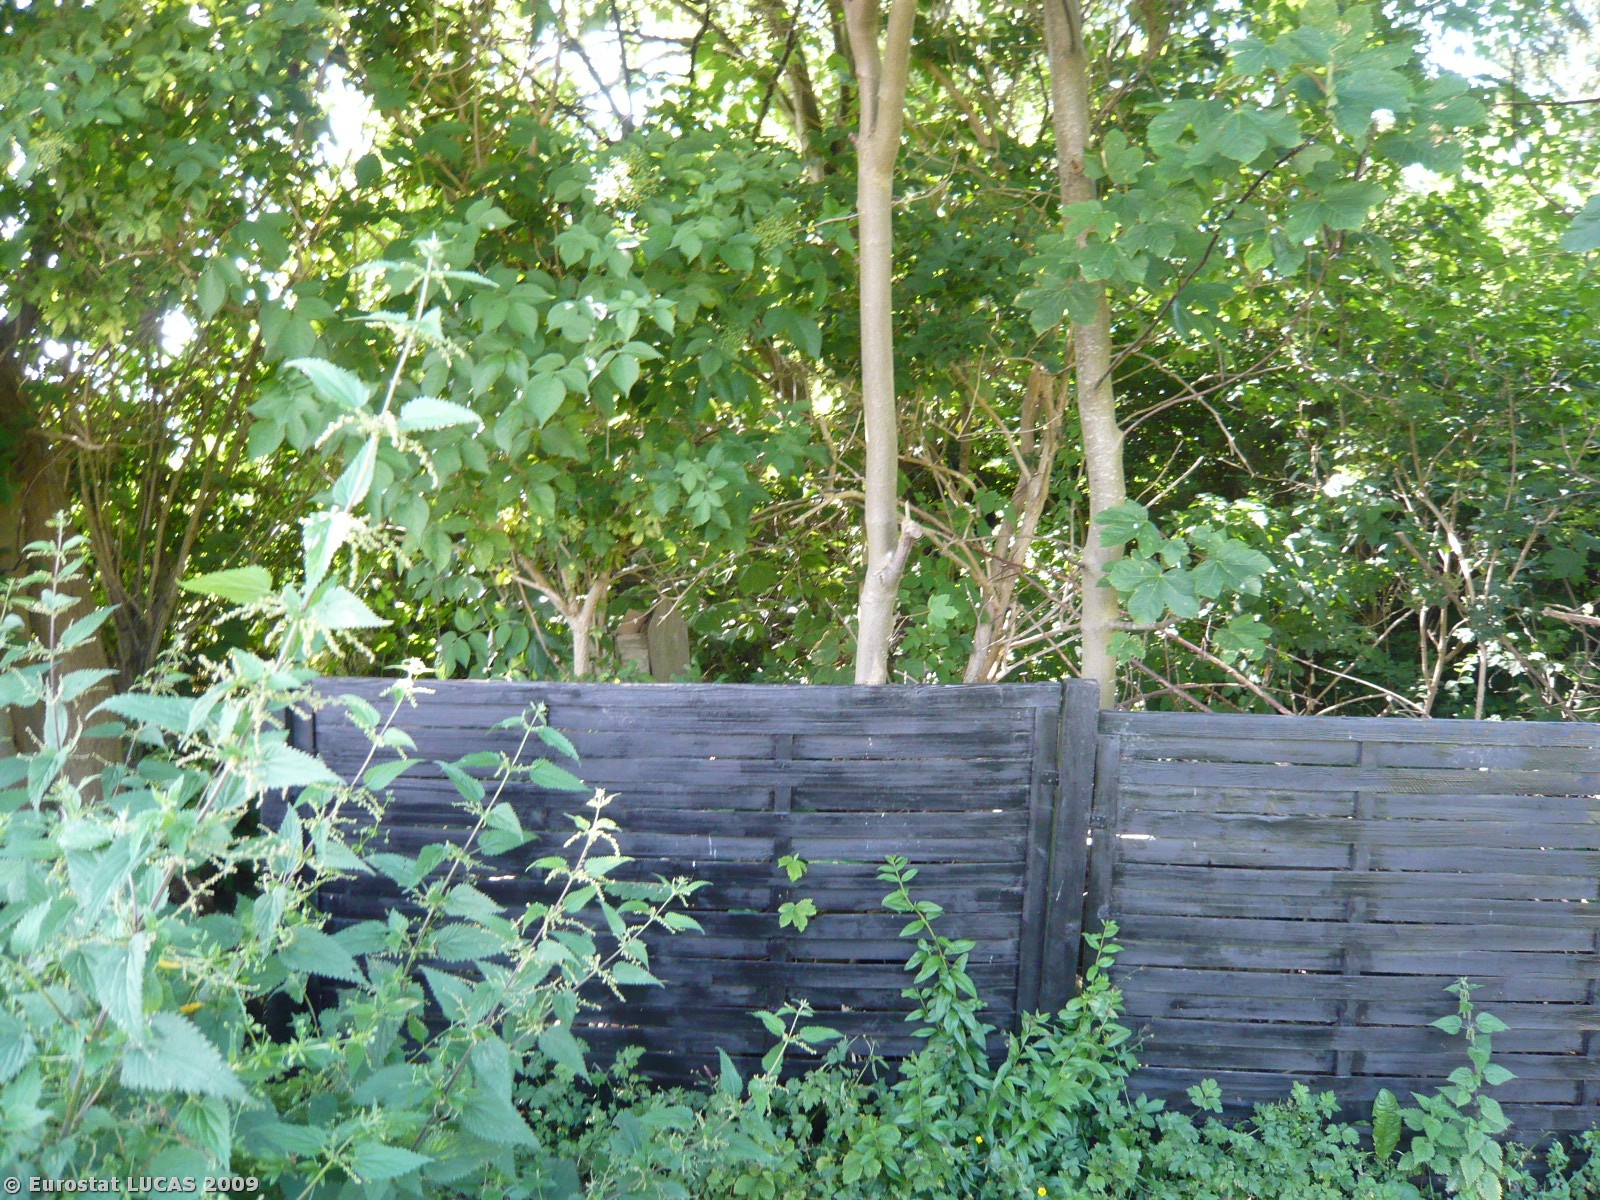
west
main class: Grassland
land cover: Grassland without tree/shrub cover
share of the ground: > 75 %
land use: Agriculture (excluding fallow land and kitchen gardens)
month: July
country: DK
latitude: 55.7809
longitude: 11.7044
